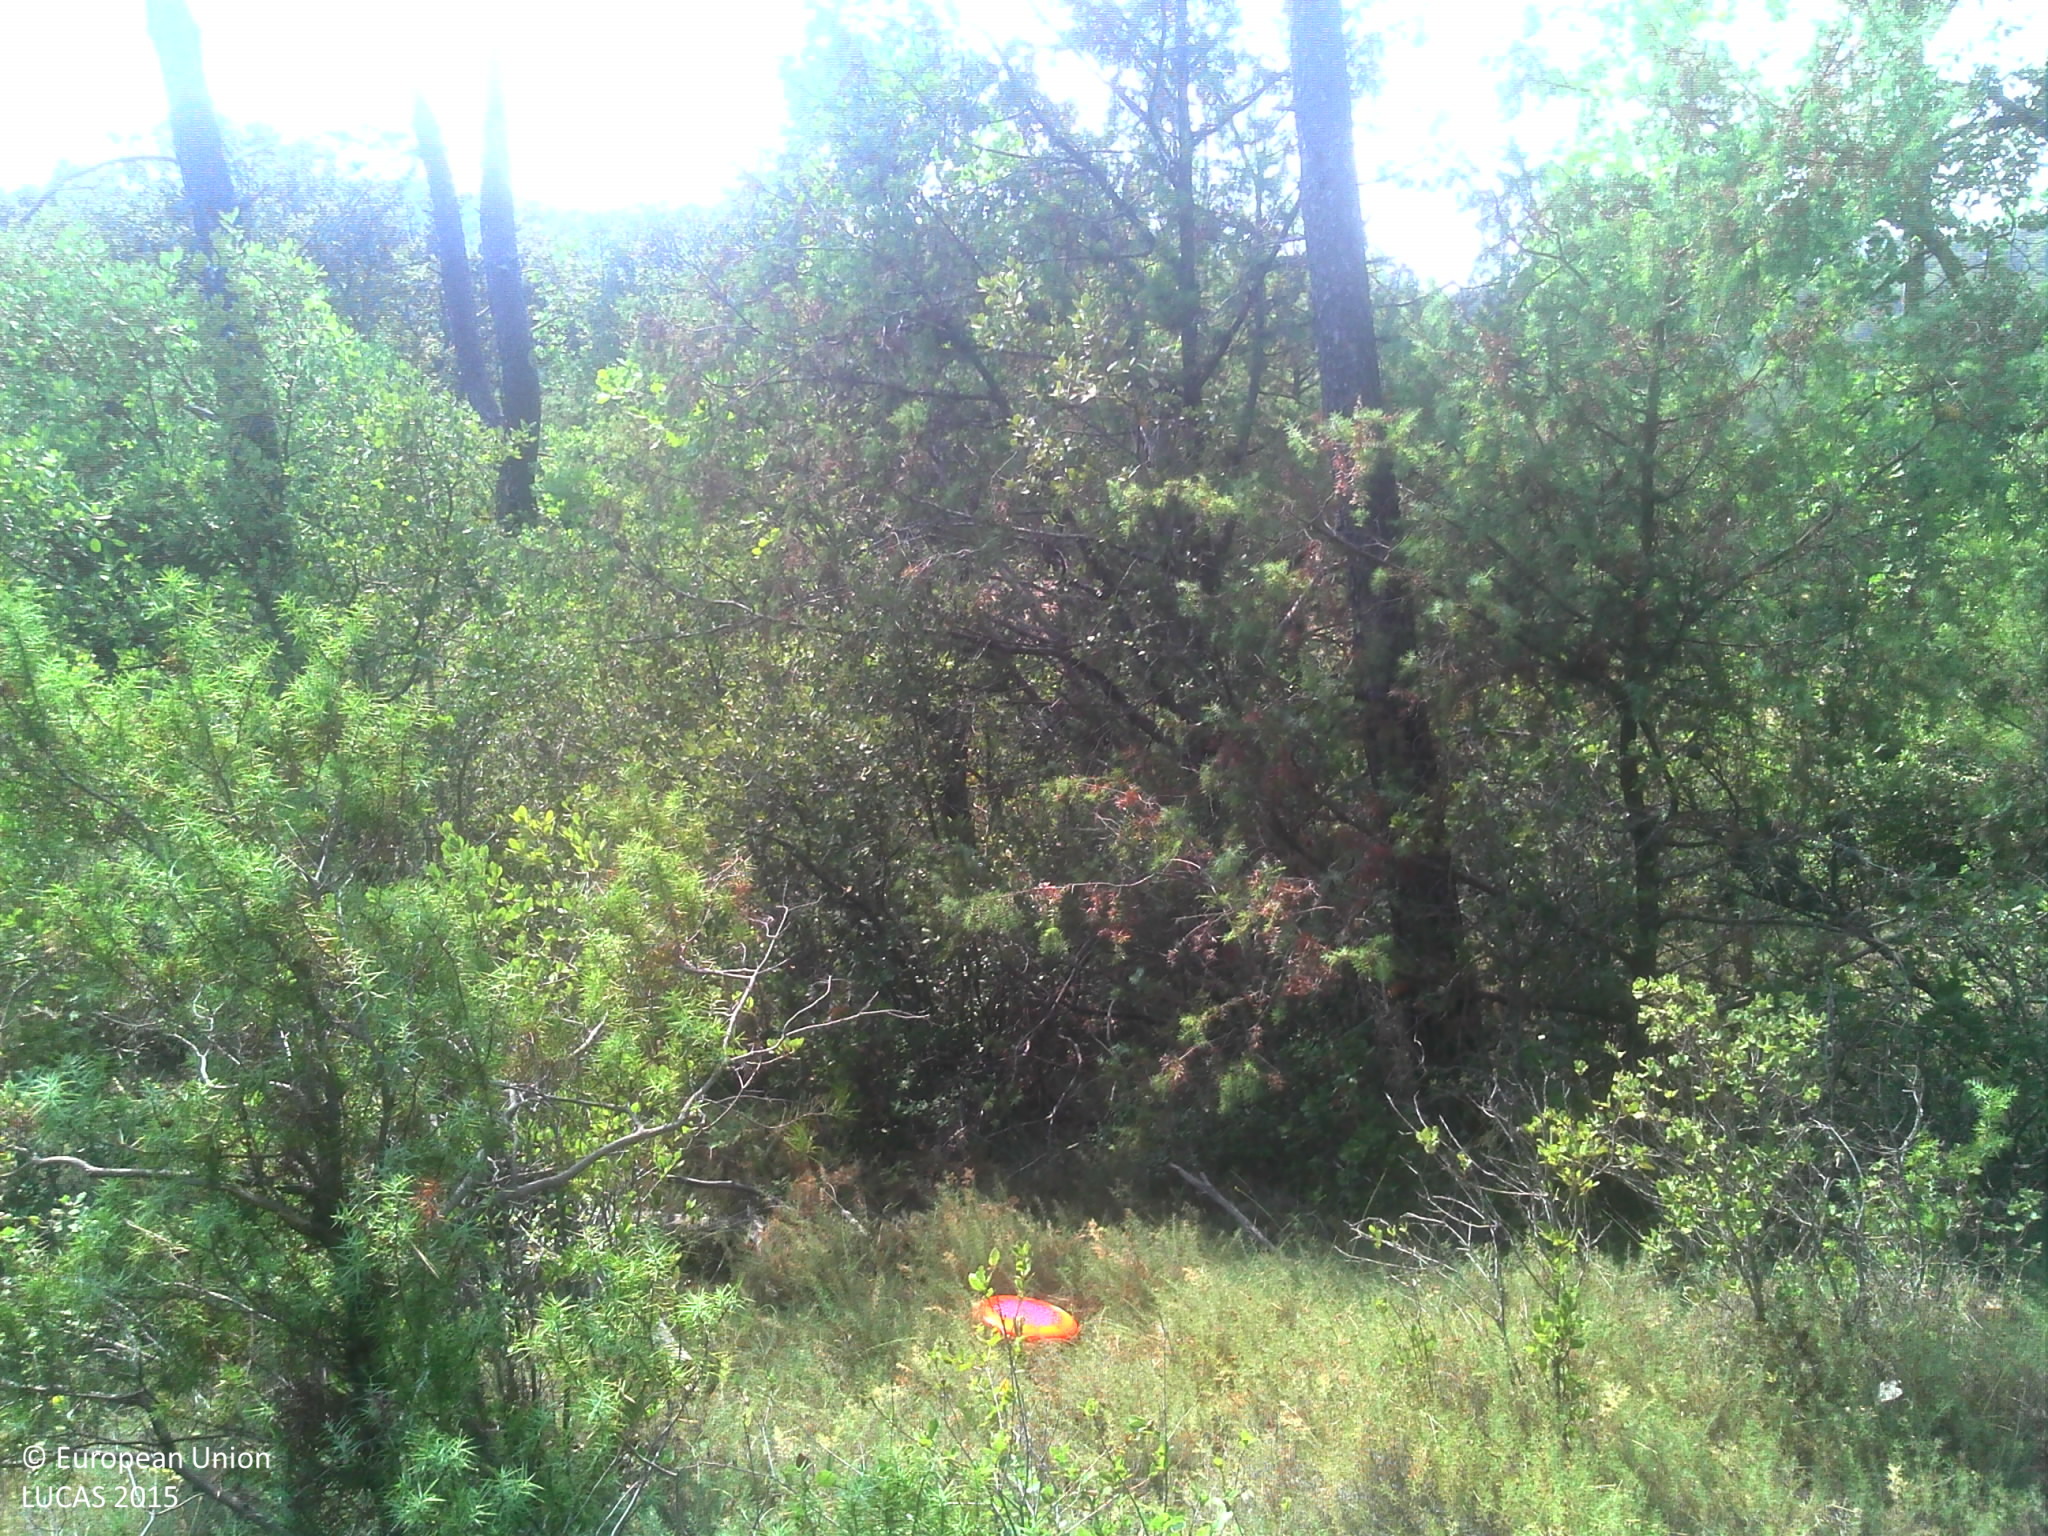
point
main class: Woodland
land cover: Pine dominated mixed woodland
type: coniferous forest of the mediterranean region
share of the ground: > 75 %
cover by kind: broadleaved forest trees 40 %, coniferous forest trees 35 %, shrubs 20 %, herbaceous plants 5 %
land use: Semi-natural and natural areas not in use
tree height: > 5 m
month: July
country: FR
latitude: 43.4561
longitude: 6.3630
